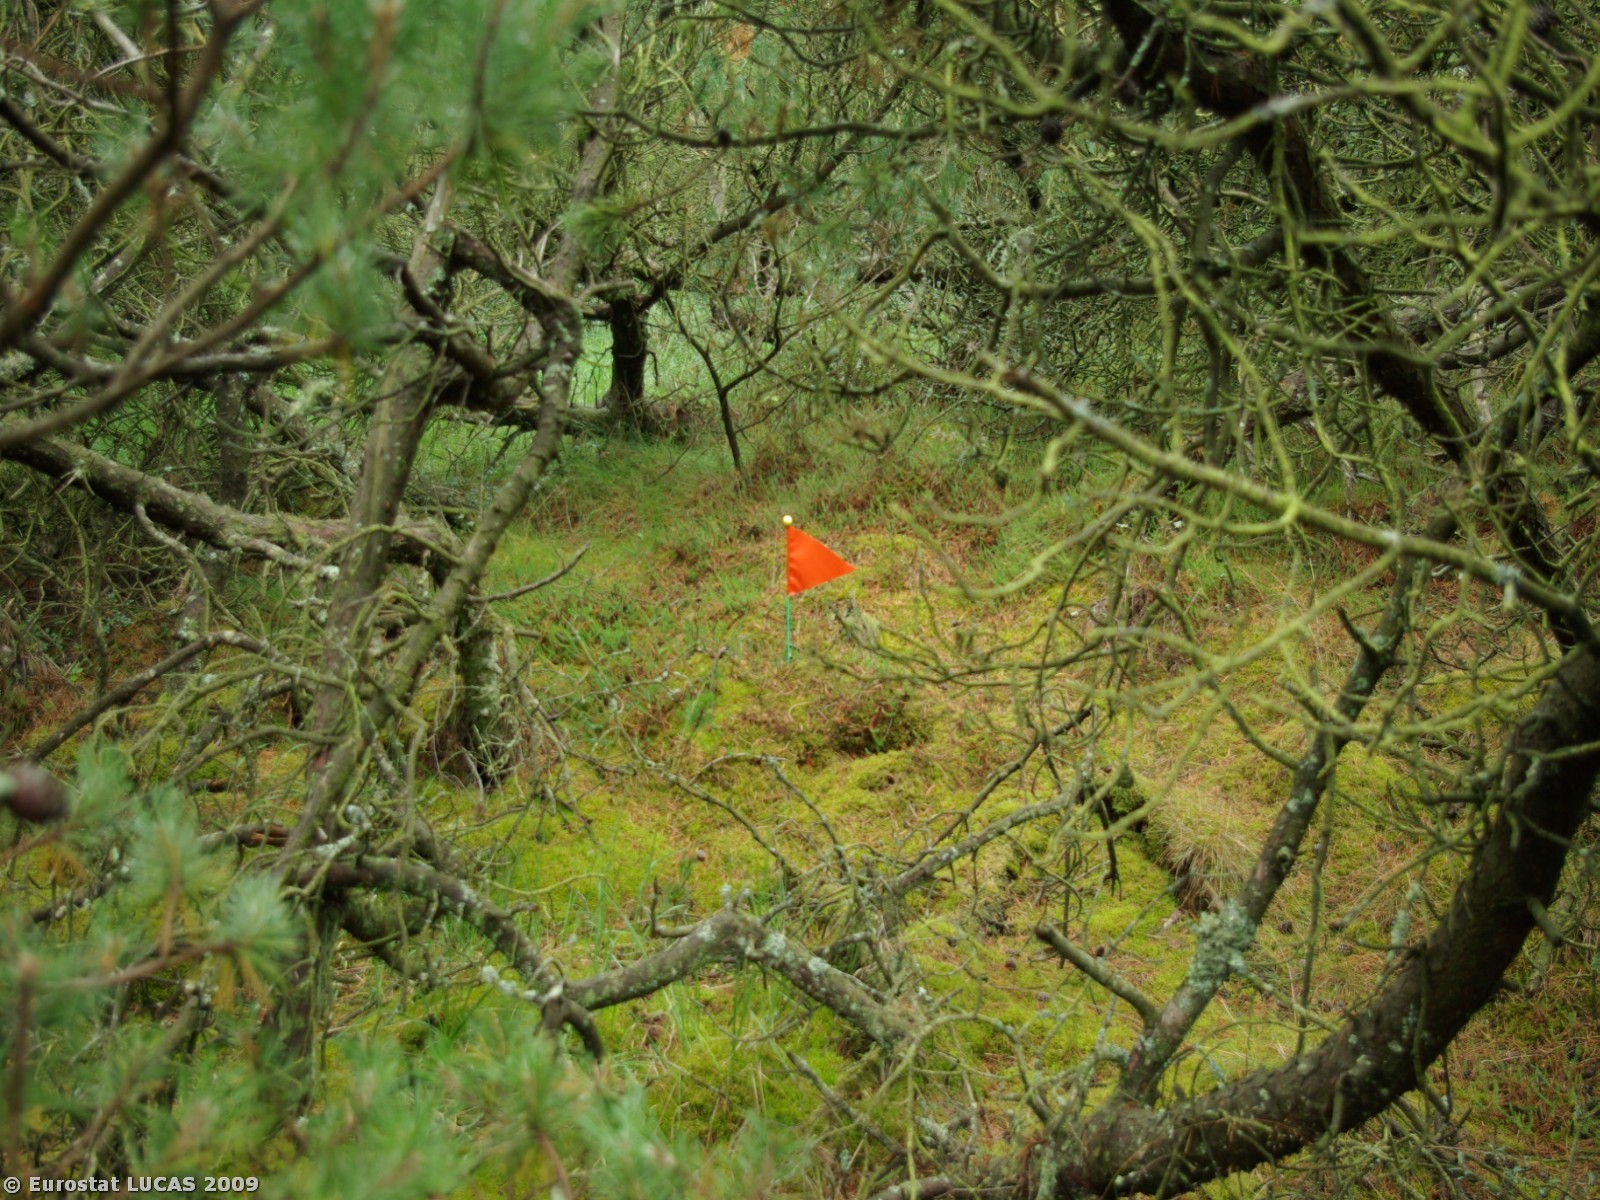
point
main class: Woodland
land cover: Coniferous woodland
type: hemiboreal forest and nemoral coniferous forest and mixed broadleaved-coniferous forest
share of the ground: > 75 %
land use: Unused
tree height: > 5 m
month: July
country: DK
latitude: 55.1188
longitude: 8.5429
